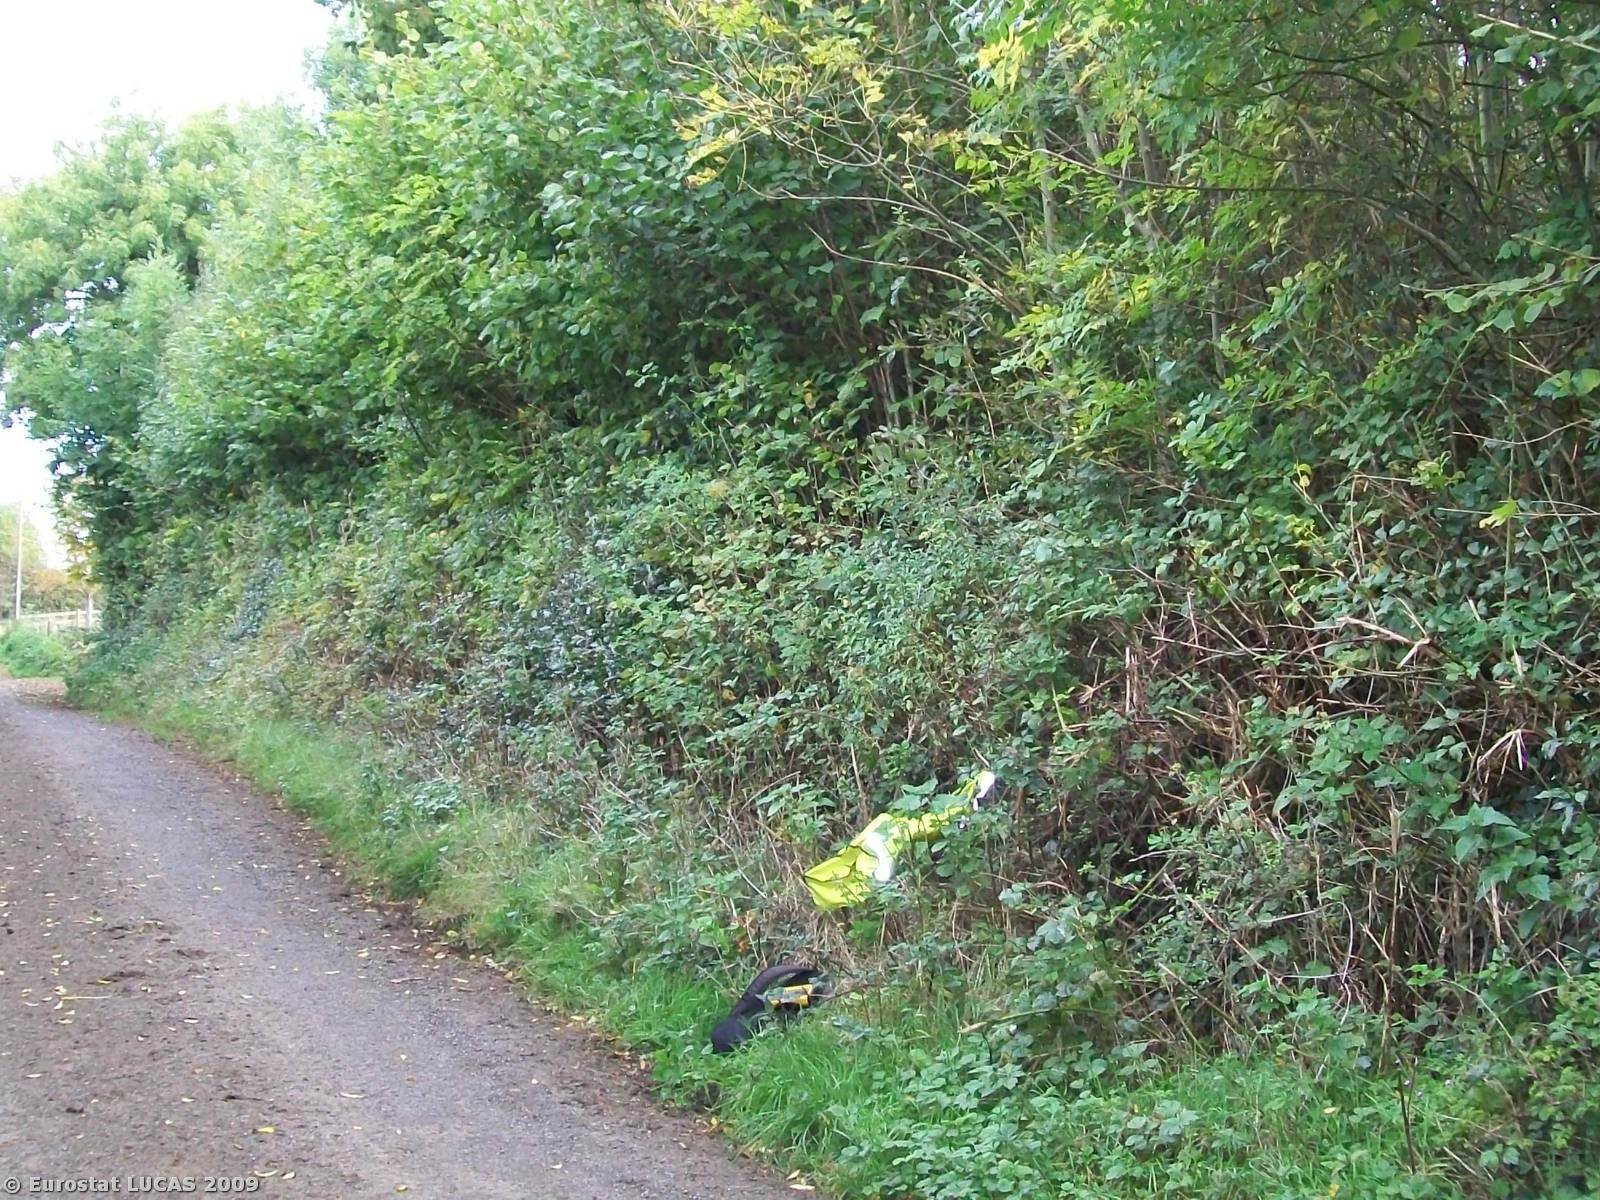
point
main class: Artificial land
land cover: Non built-up linear features
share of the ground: > 75 %
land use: Road transport
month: September
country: IE
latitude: 53.0235
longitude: -8.3005
